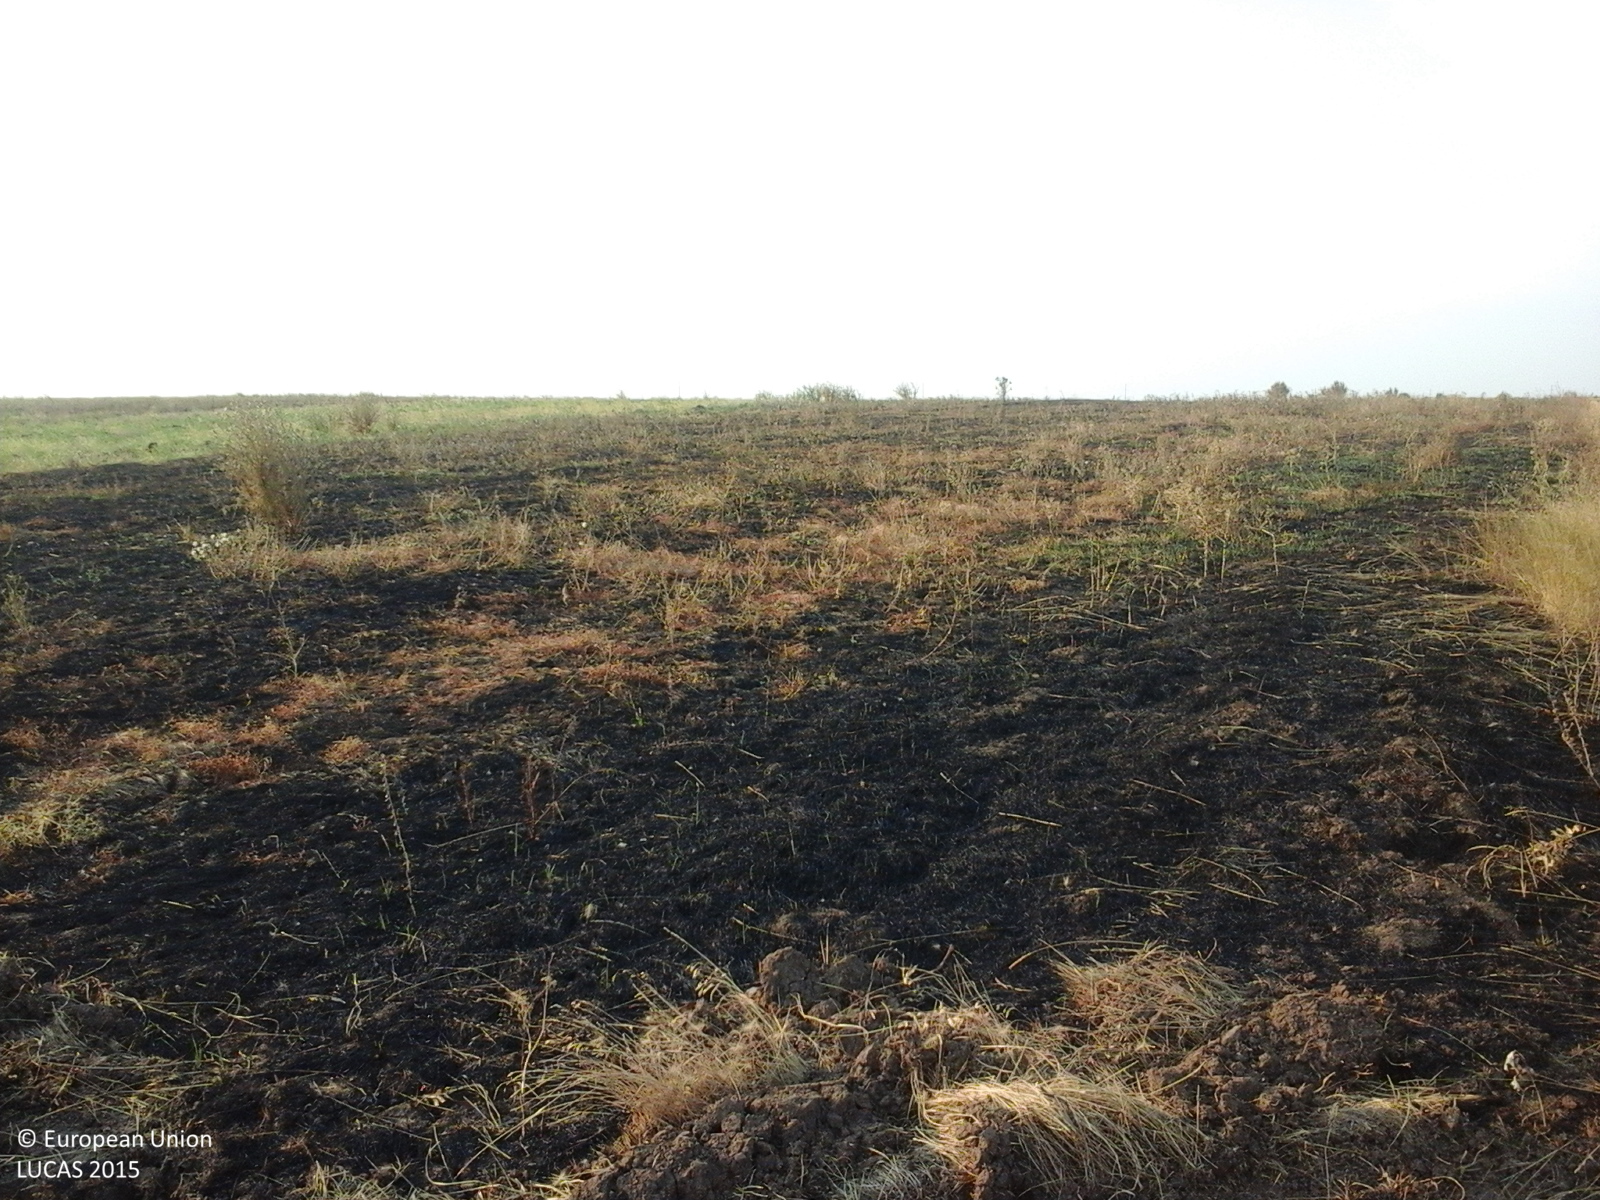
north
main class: Grassland
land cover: Spontaneously vegetated surfaces
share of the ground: > 75 %
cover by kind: herbaceous plants 100 %
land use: Fallow land
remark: Burnt area
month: August
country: RO
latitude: 44.2553
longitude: 23.5920
